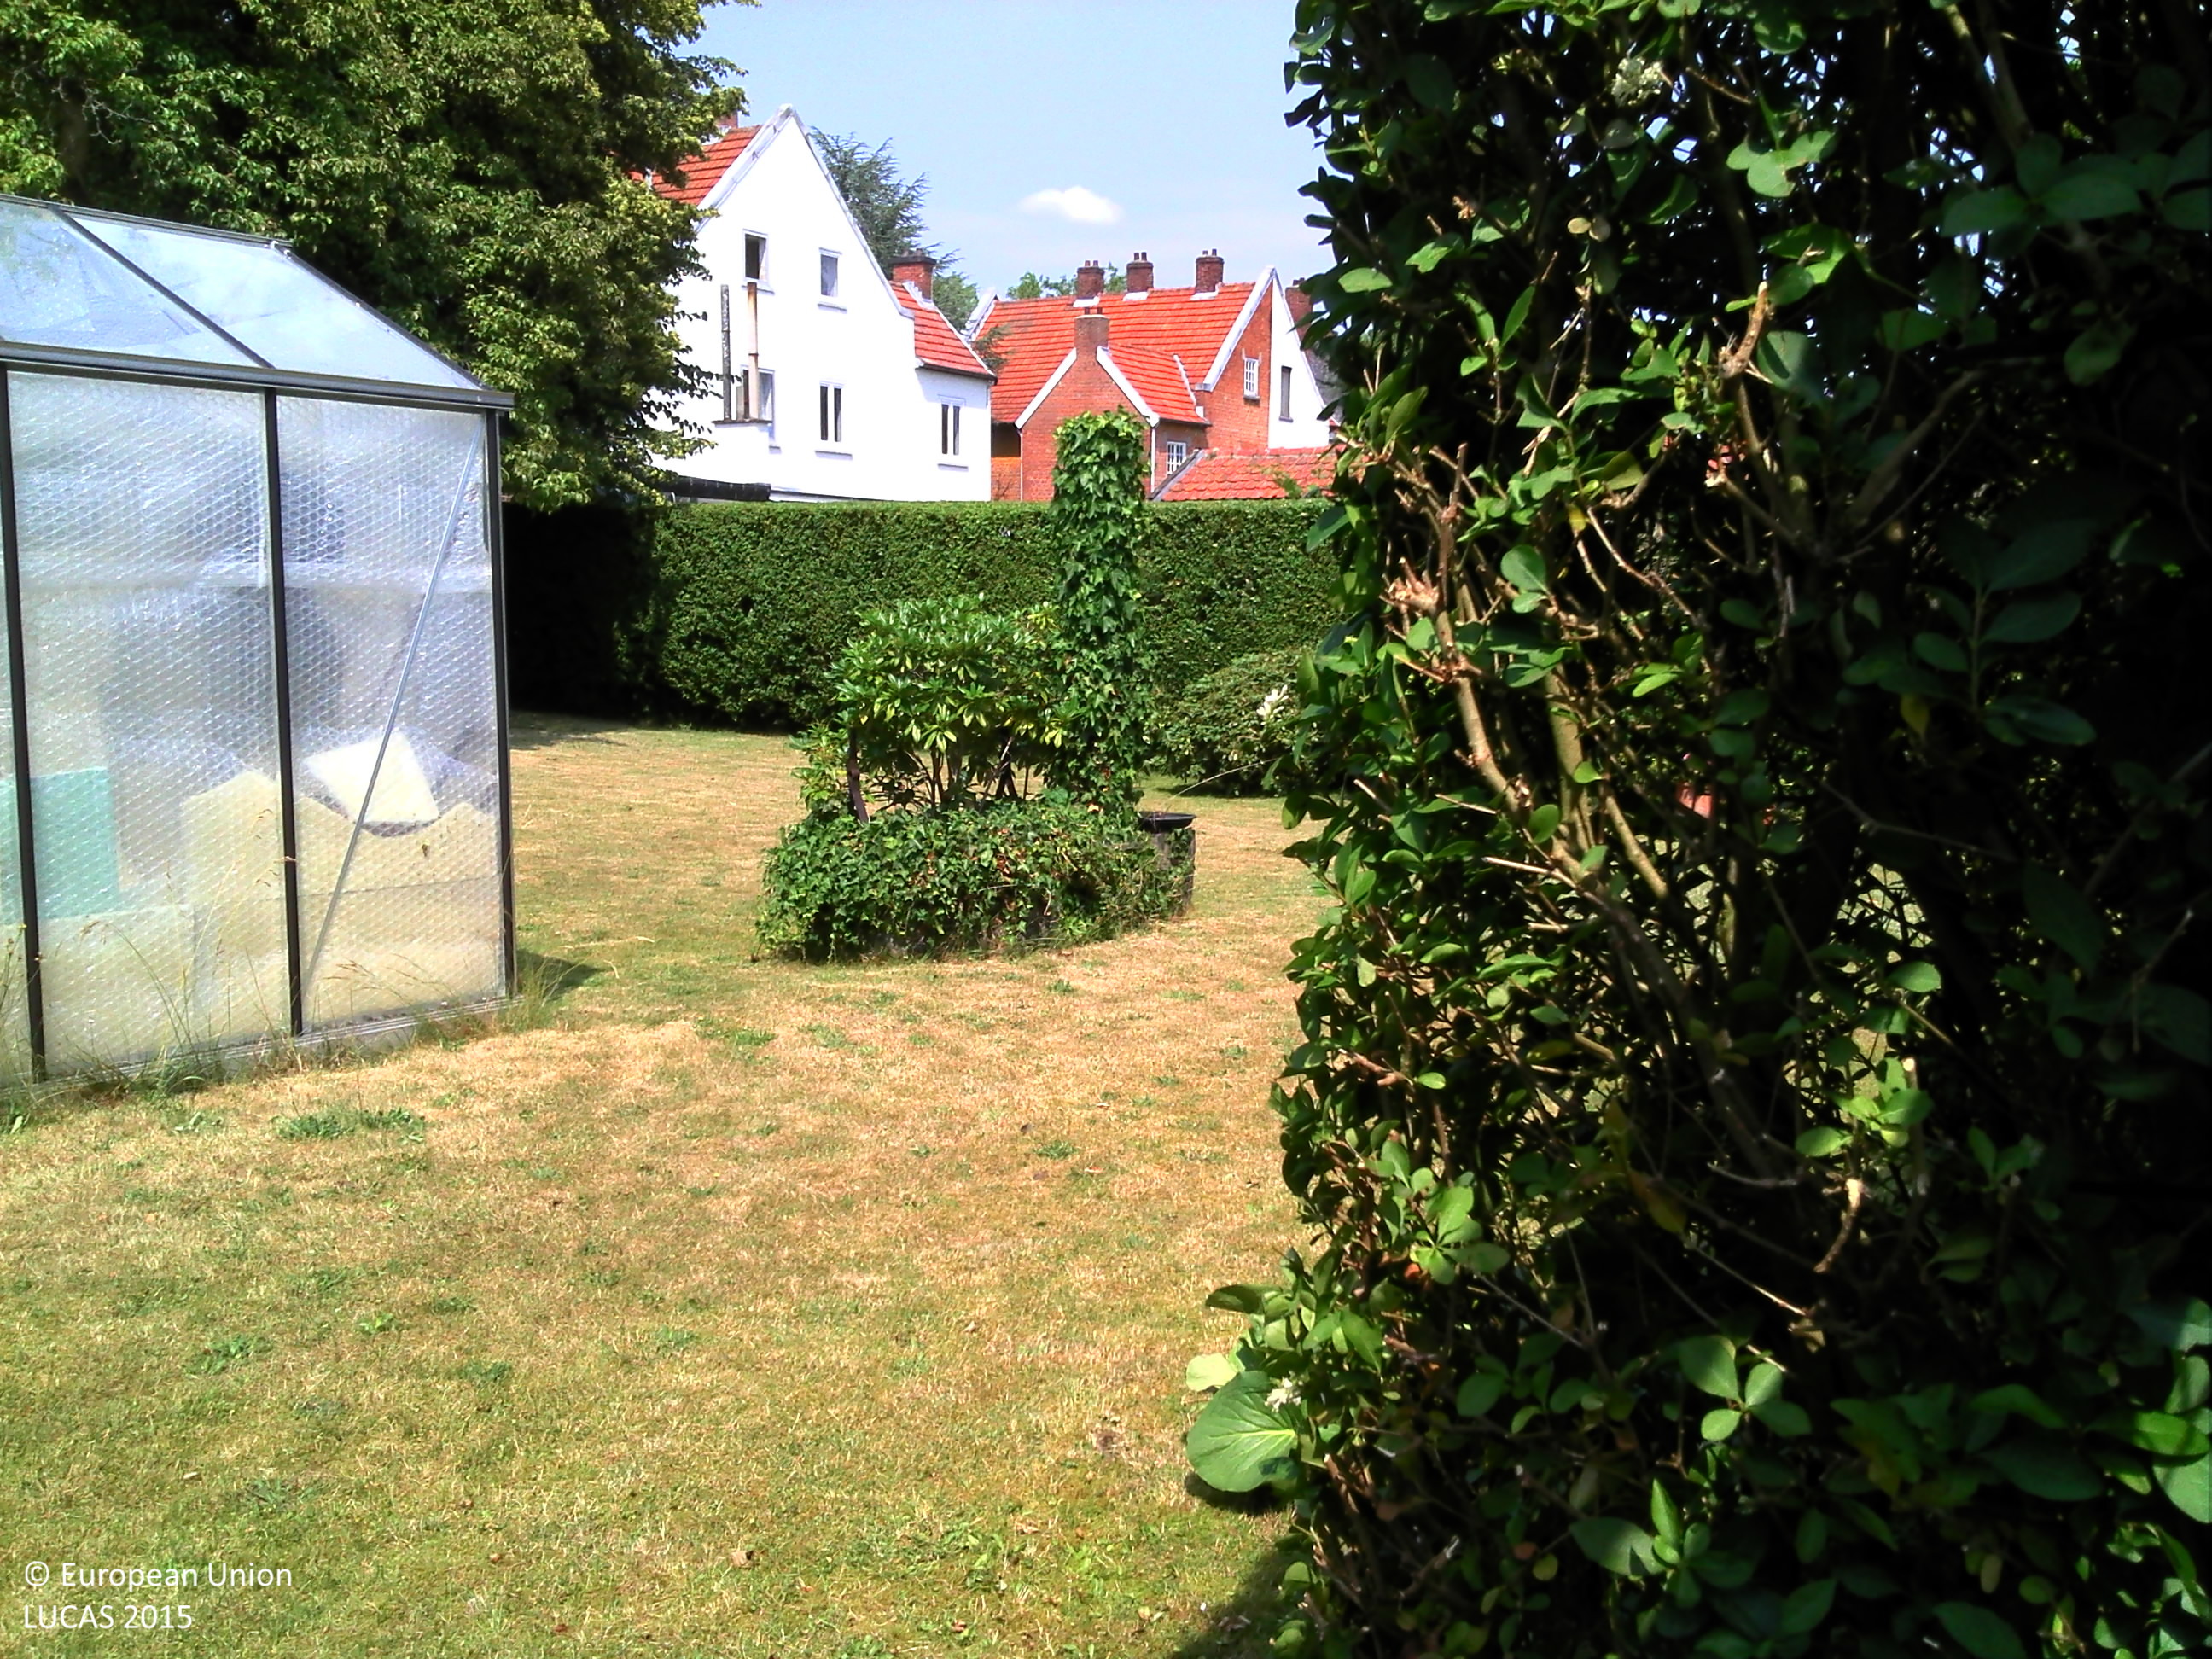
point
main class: Grassland
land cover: Grassland with sparse tree/shrub cover
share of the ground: > 75 %
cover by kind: herbaceous plants 95 %, broadleaved forest trees 5 %
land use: Residential
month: July
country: BE
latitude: 50.9772
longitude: 5.4832
